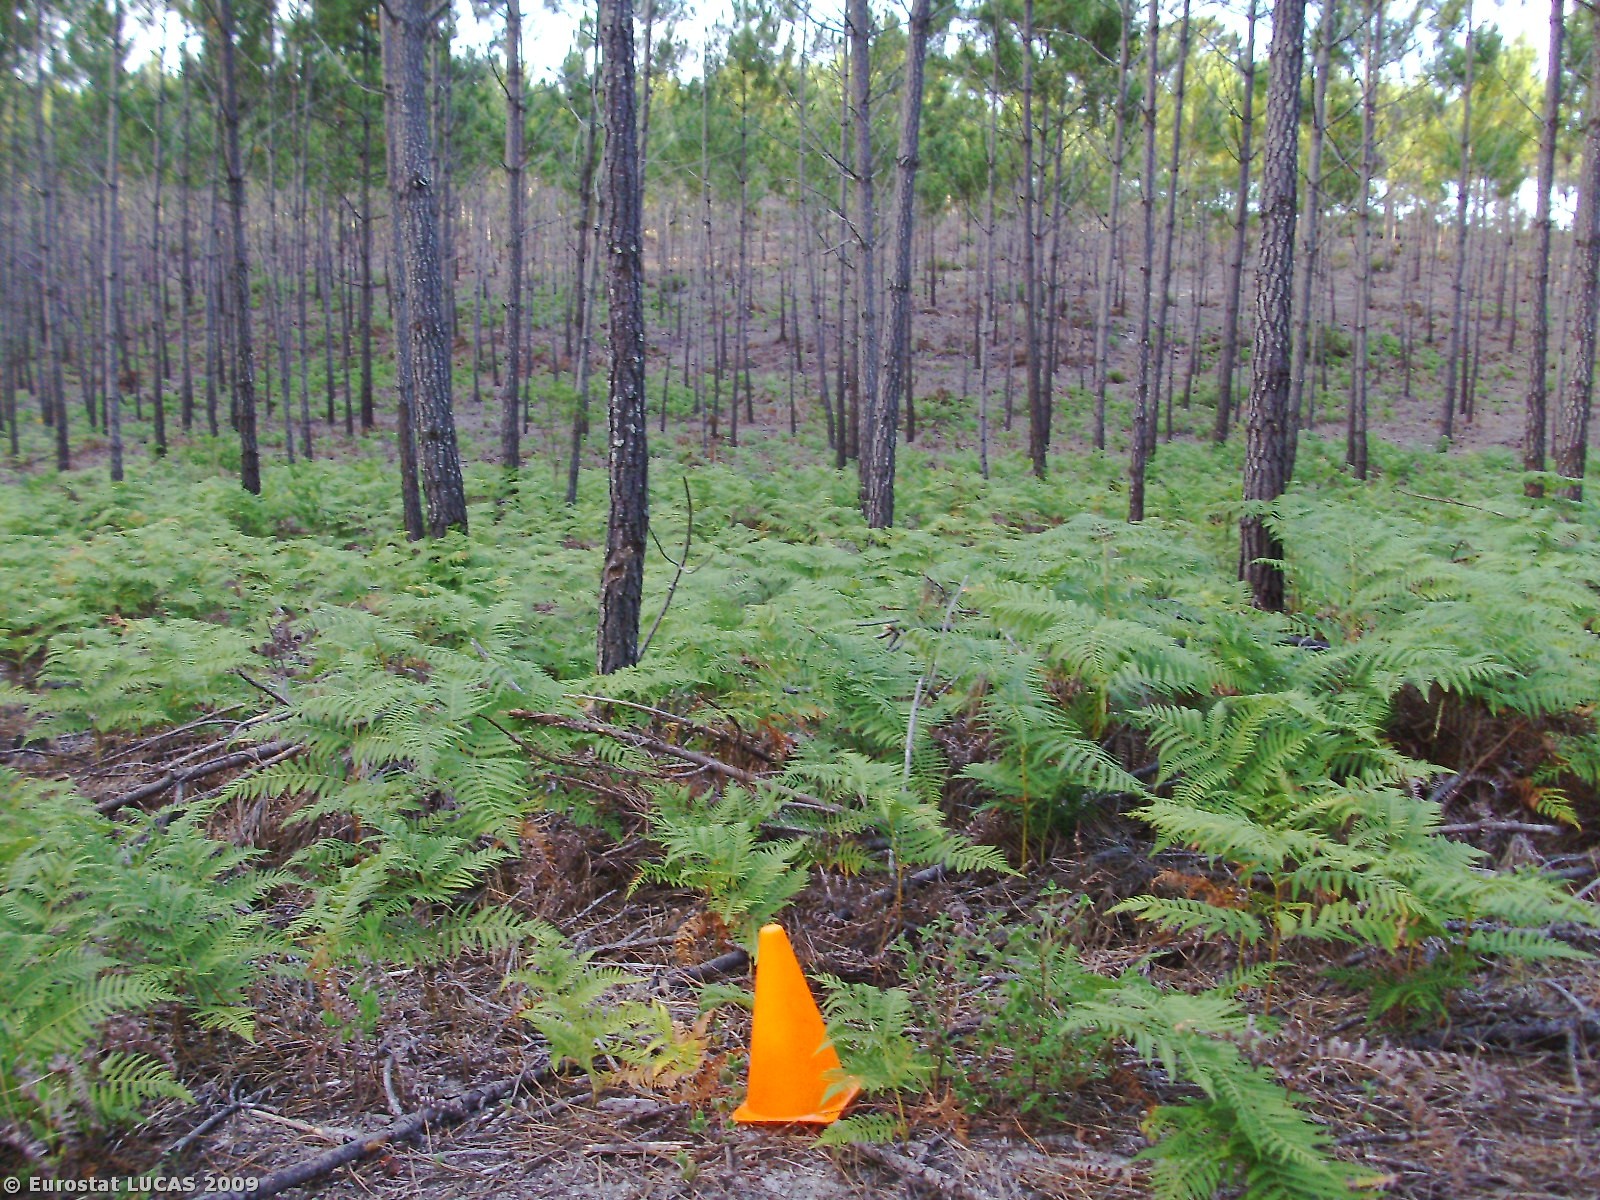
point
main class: Woodland
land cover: Coniferous woodland
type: coniferous forest of the mediterranean region
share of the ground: > 75 %
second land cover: Spontaneously vegetated surfaces
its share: 10 - 25 %
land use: Forestry
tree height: > 5 m
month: July
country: PT
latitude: 39.6630
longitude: -9.0322
